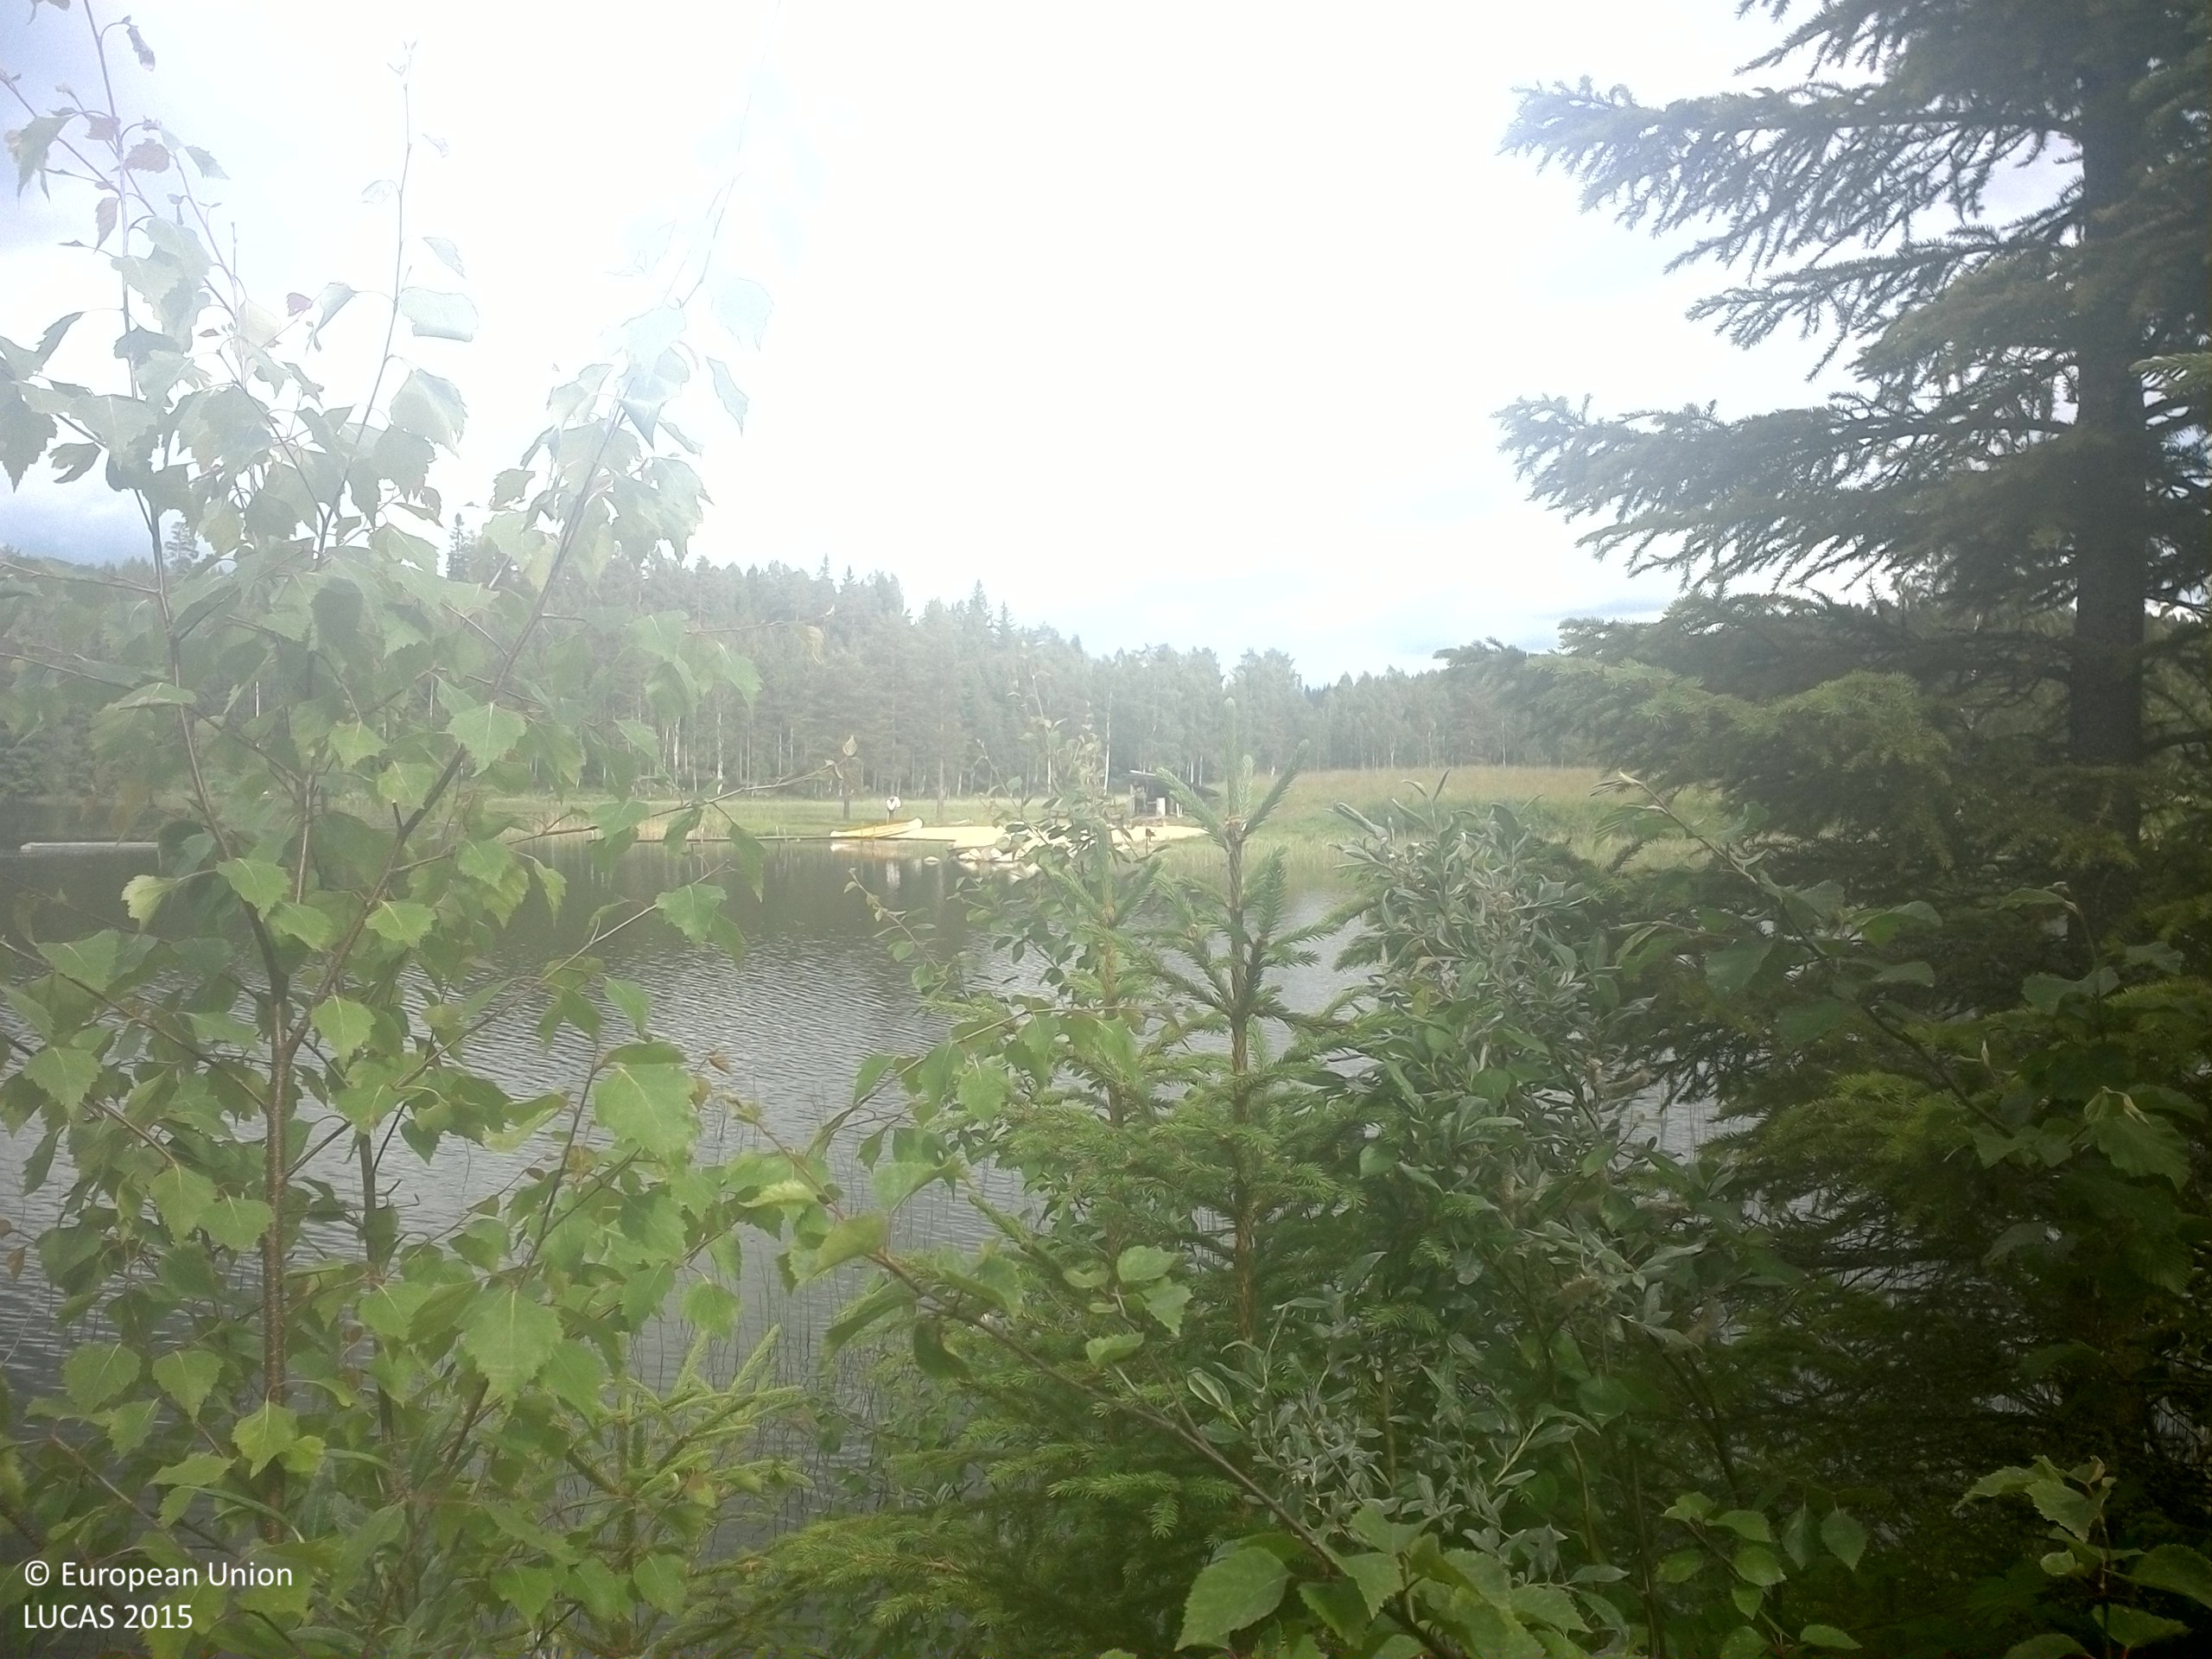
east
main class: Woodland
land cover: Spruce dominated mixed woodland
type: boreal forest
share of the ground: > 75 %
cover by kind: coniferous forest trees 60 %, broadleaved forest trees 30 %, shrubs 10 %
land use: Forestry
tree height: < 5 m
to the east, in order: Spruce dominated mixed woodland; Inland fresh water bodies; Inland marshes; Grassland without tree/shrub cover; Inland marshes; Lines of trees
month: July
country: SE
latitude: 63.5864
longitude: 17.8520
